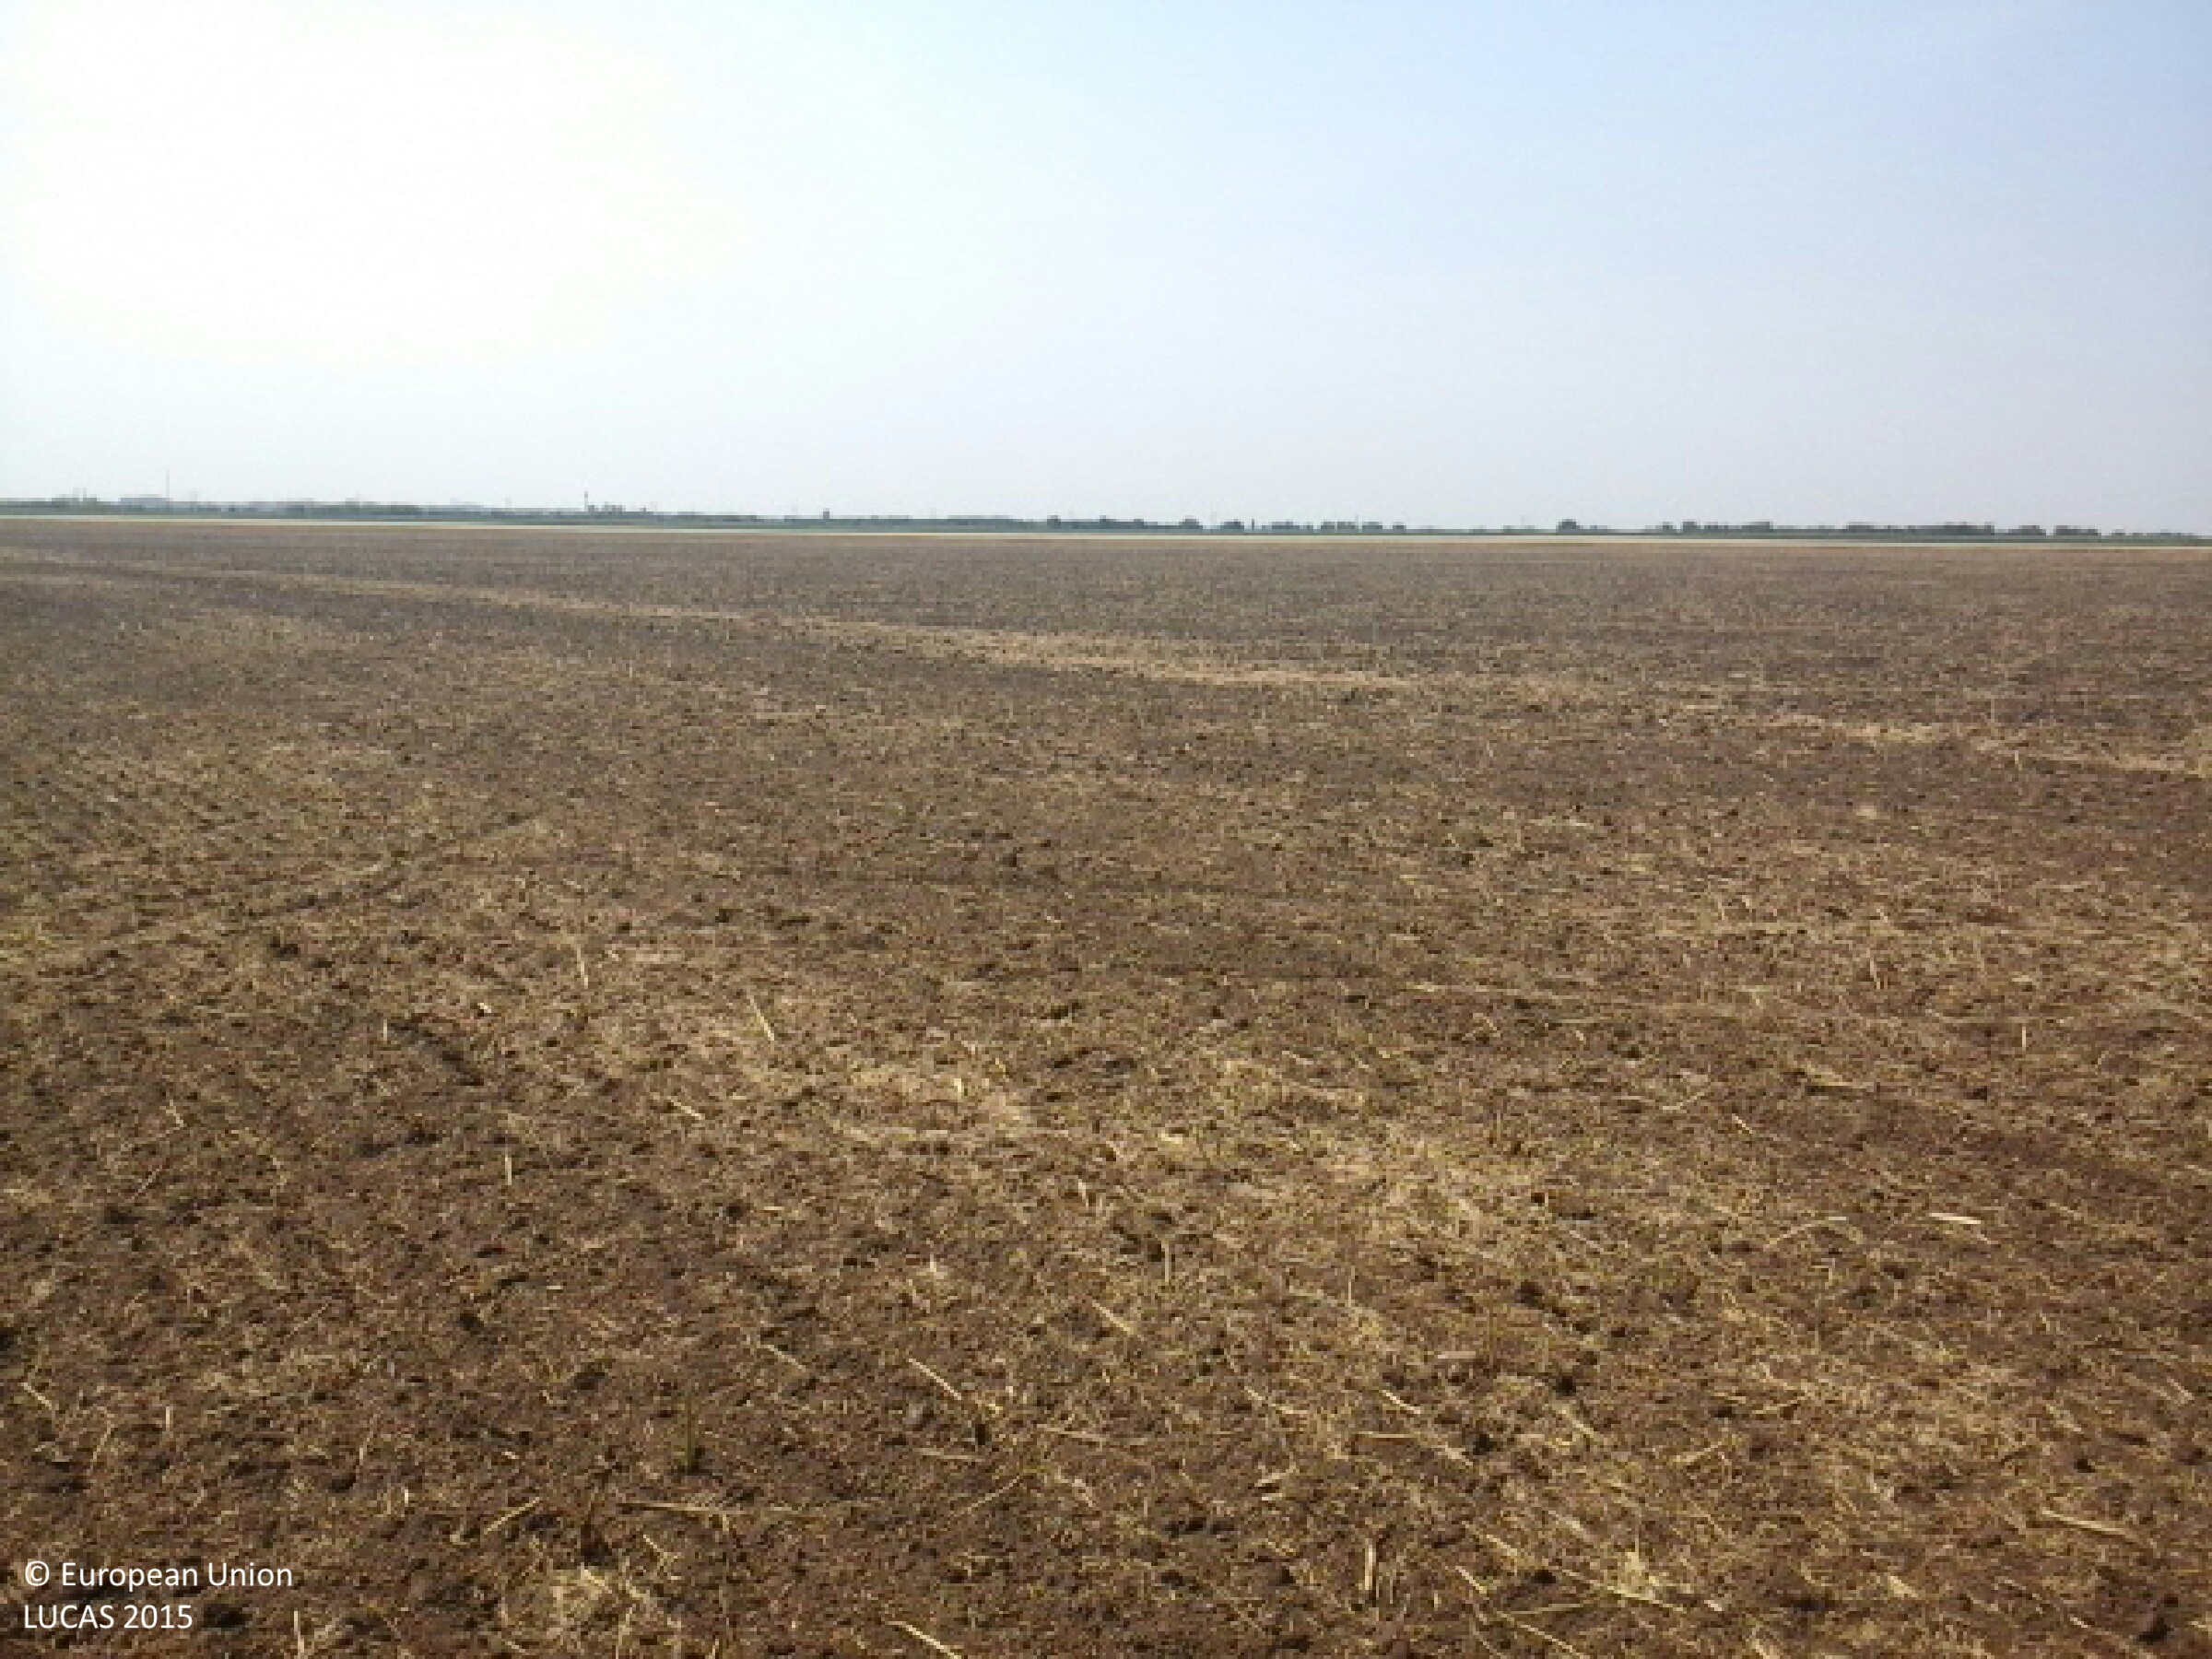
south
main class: Cropland
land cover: Rape and turnip rape
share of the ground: < 10 %
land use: Agriculture (excluding fallow land and kitchen gardens)
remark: Harvested field
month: July
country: HU
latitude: 48.0499
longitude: 21.0267
